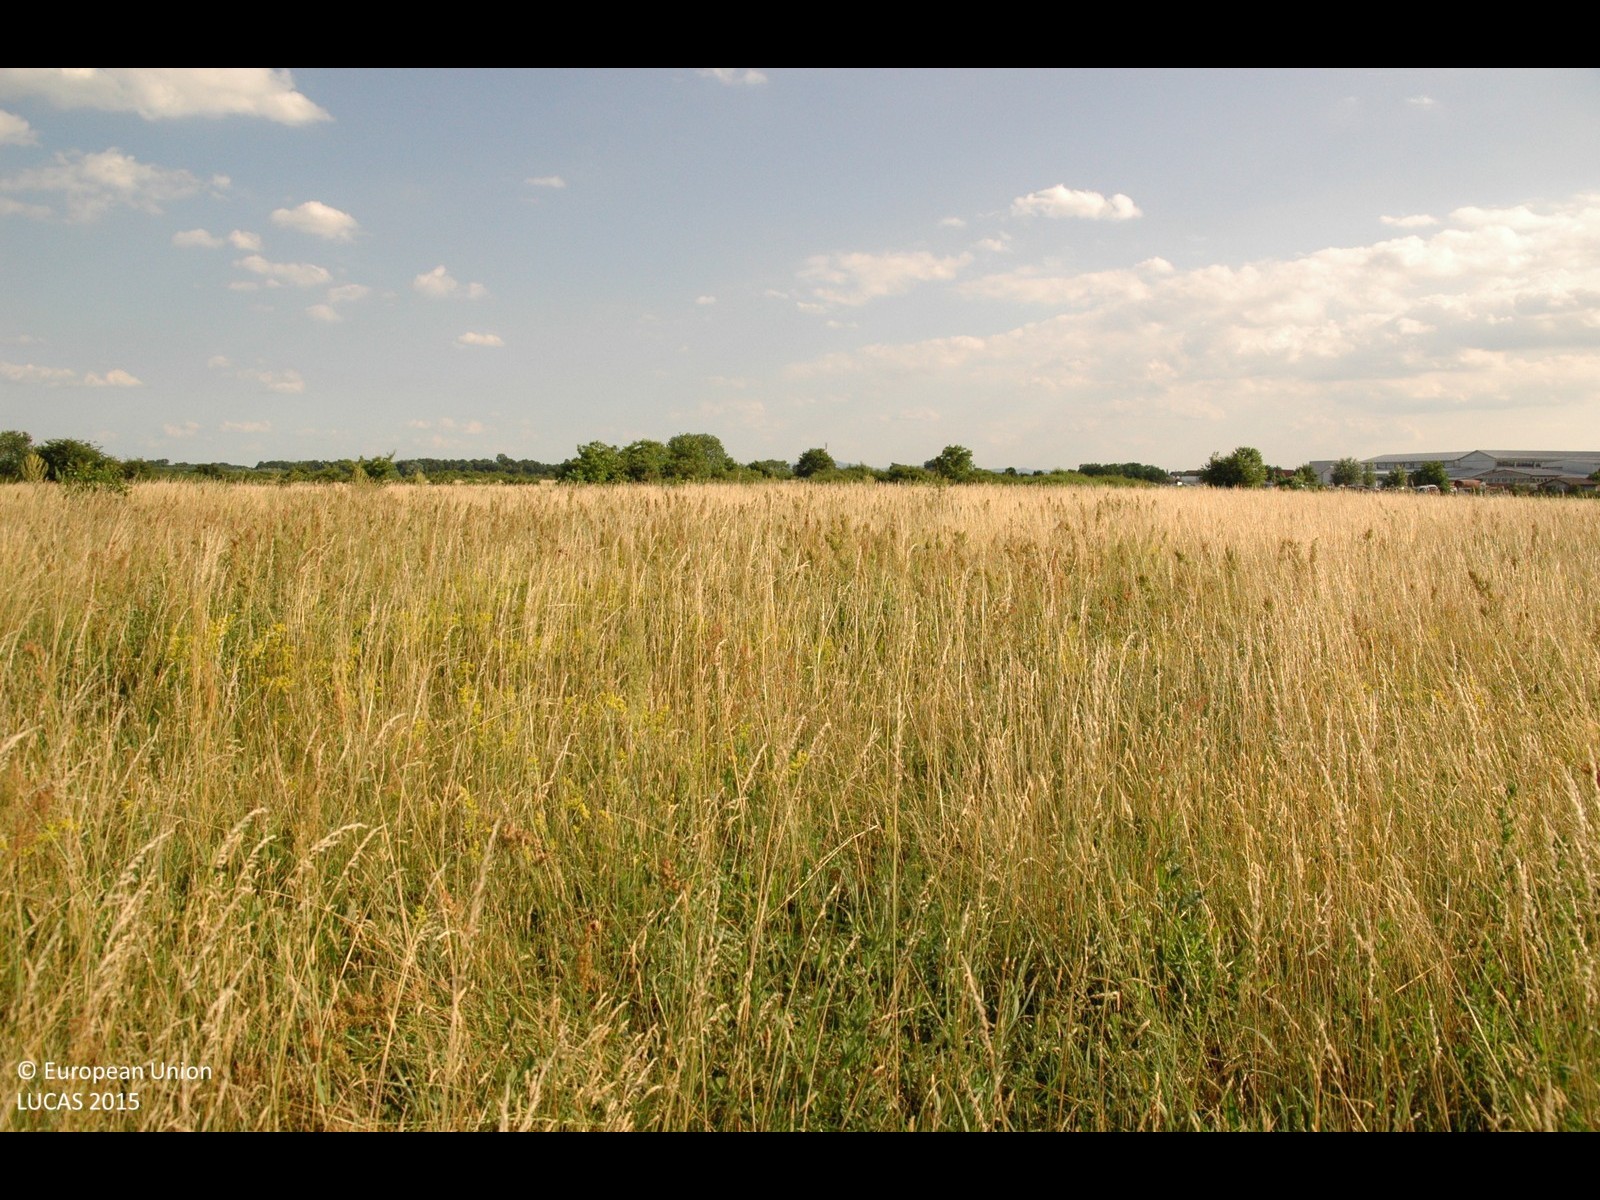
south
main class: Grassland
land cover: Grassland without tree/shrub cover
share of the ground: > 75 %
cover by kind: herbaceous plants 100 %
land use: Agriculture (excluding fallow land and kitchen gardens)
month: June
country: HR
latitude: 46.3890
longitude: 16.4897
